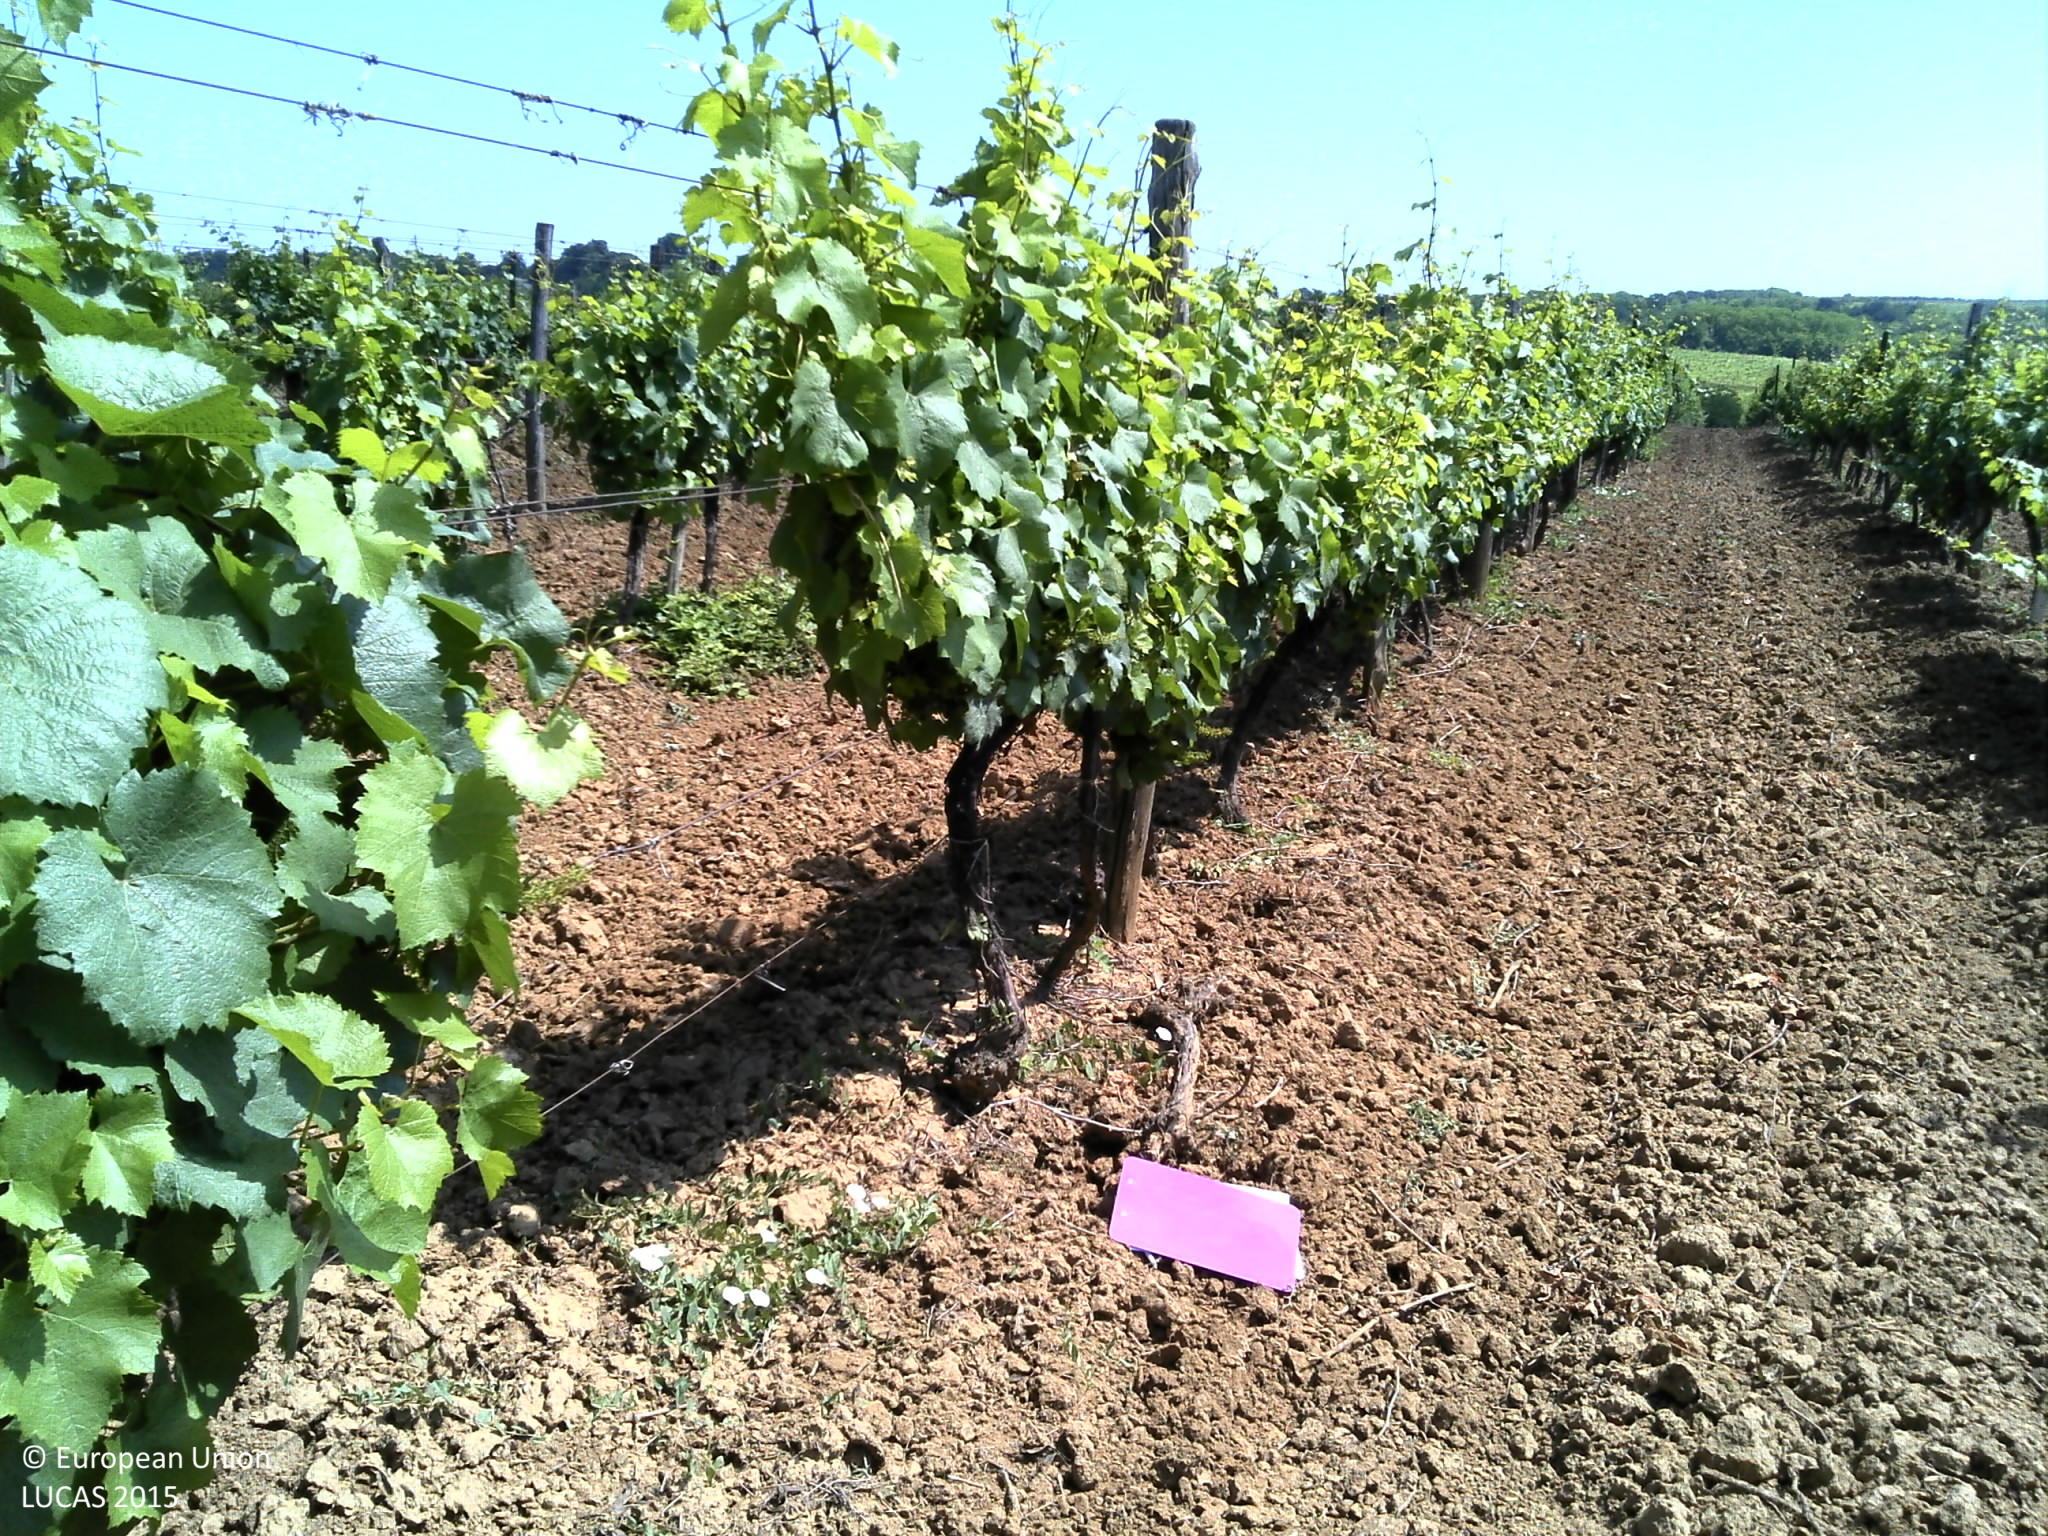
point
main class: Cropland
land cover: Vineyards
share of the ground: 25 - 50 %
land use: Agriculture (excluding fallow land and kitchen gardens)
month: June
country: HR
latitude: 45.7796
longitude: 18.6902
